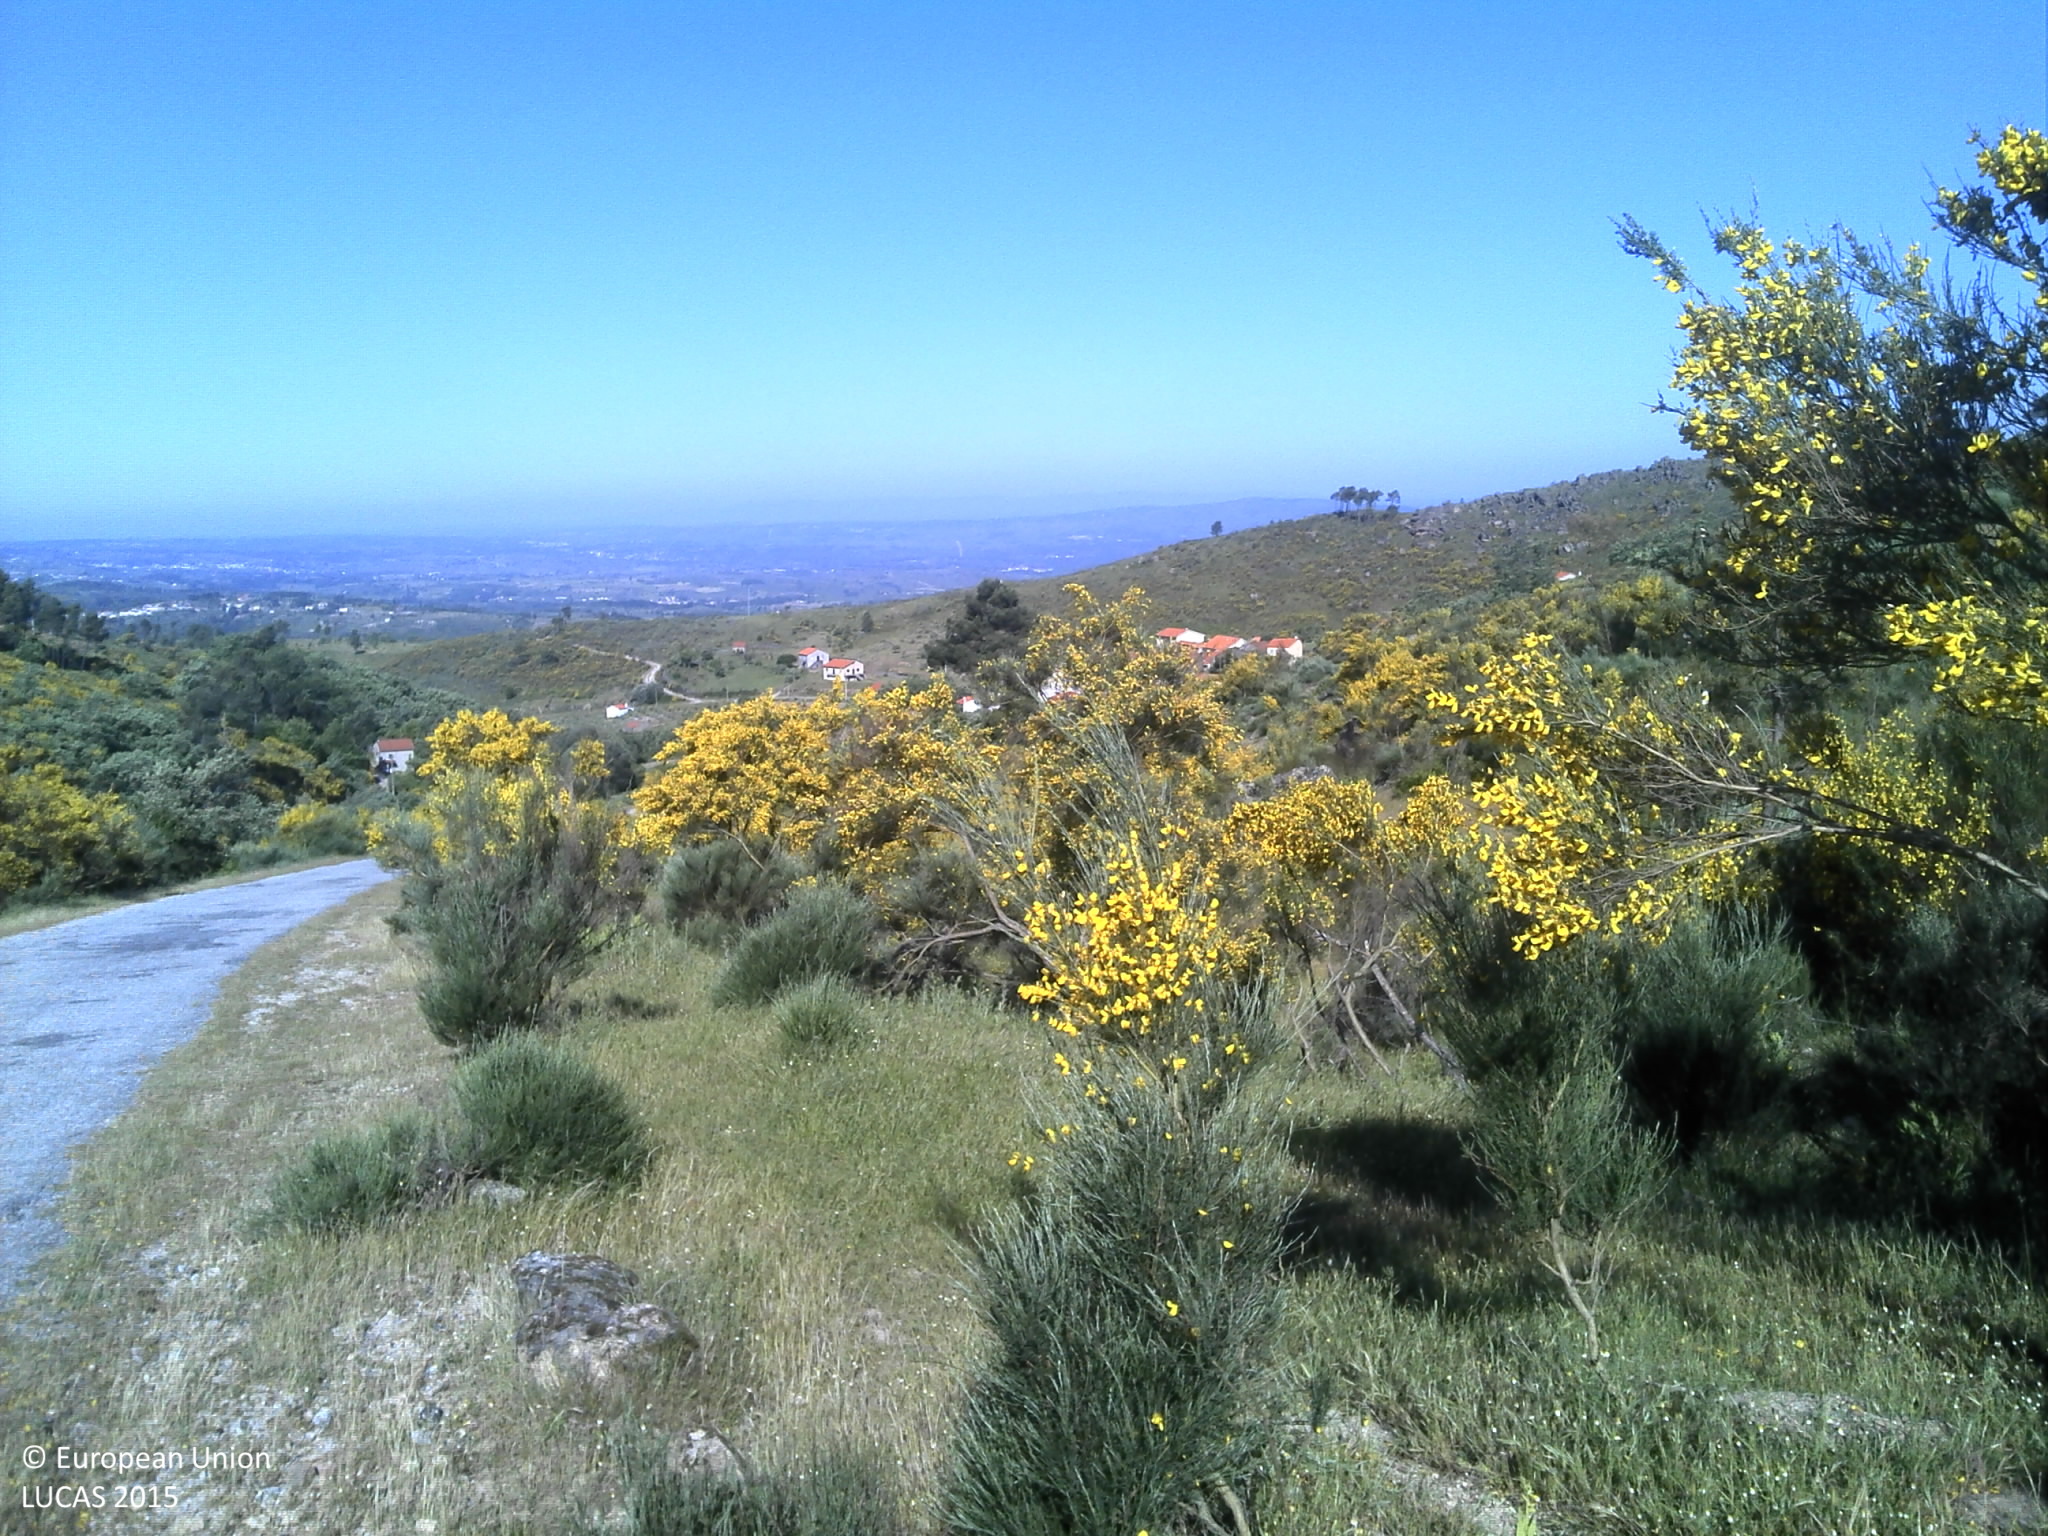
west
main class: Shrubland
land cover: Shrubland without tree cover
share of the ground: 50 - 75 %
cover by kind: shrubs 70 %, herbaceous plants 10 %, unconsolidated bare surface 10 %
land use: Semi-natural and natural areas not in use
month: May
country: PT
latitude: 40.5563
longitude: -7.4351
